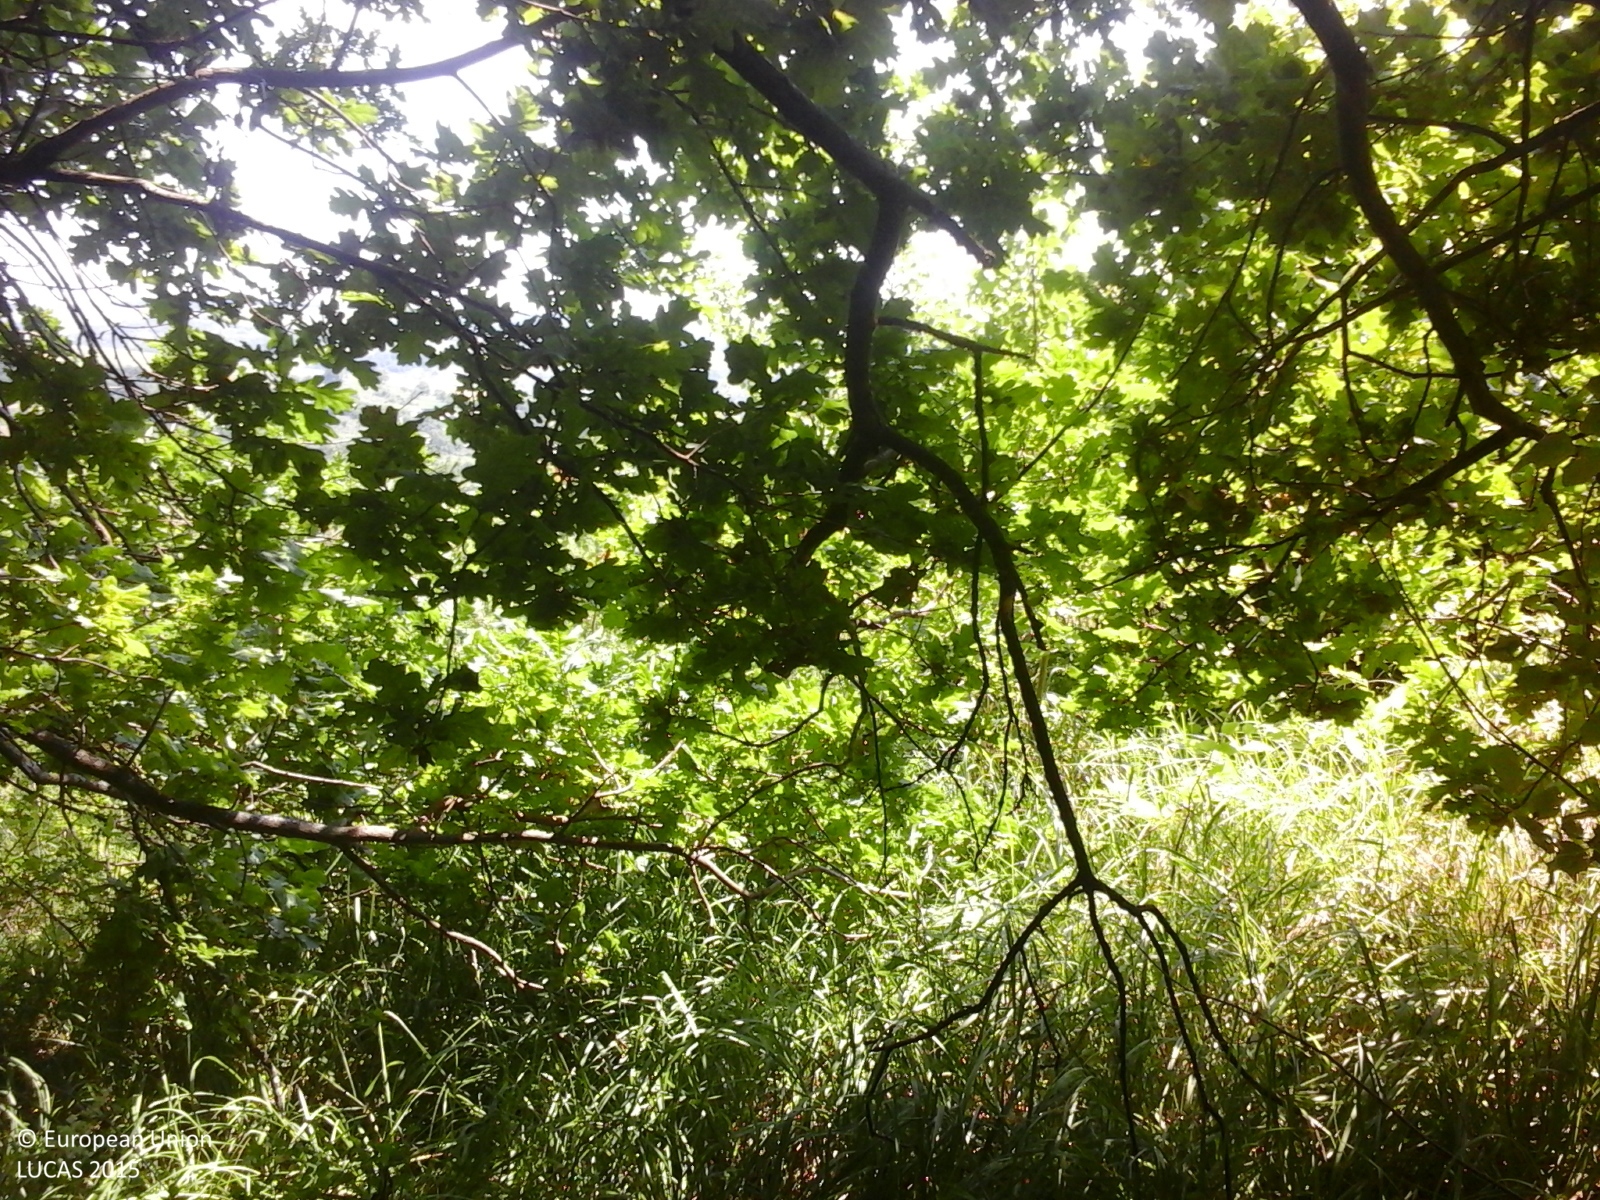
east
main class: Woodland
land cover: Broadleaved woodland
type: beech forest
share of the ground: > 75 %
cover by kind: broadleaved forest trees 85 %, herbaceous plants 10 %, shrubs 5 %
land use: Forestry
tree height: > 5 m
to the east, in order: Broadleaved woodland; Grassland without tree/shrub cover; Broadleaved woodland; Grassland with sparse tree/shrub cover; Broadleaved woodland
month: June
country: RO
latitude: 46.7415
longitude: 27.2372
